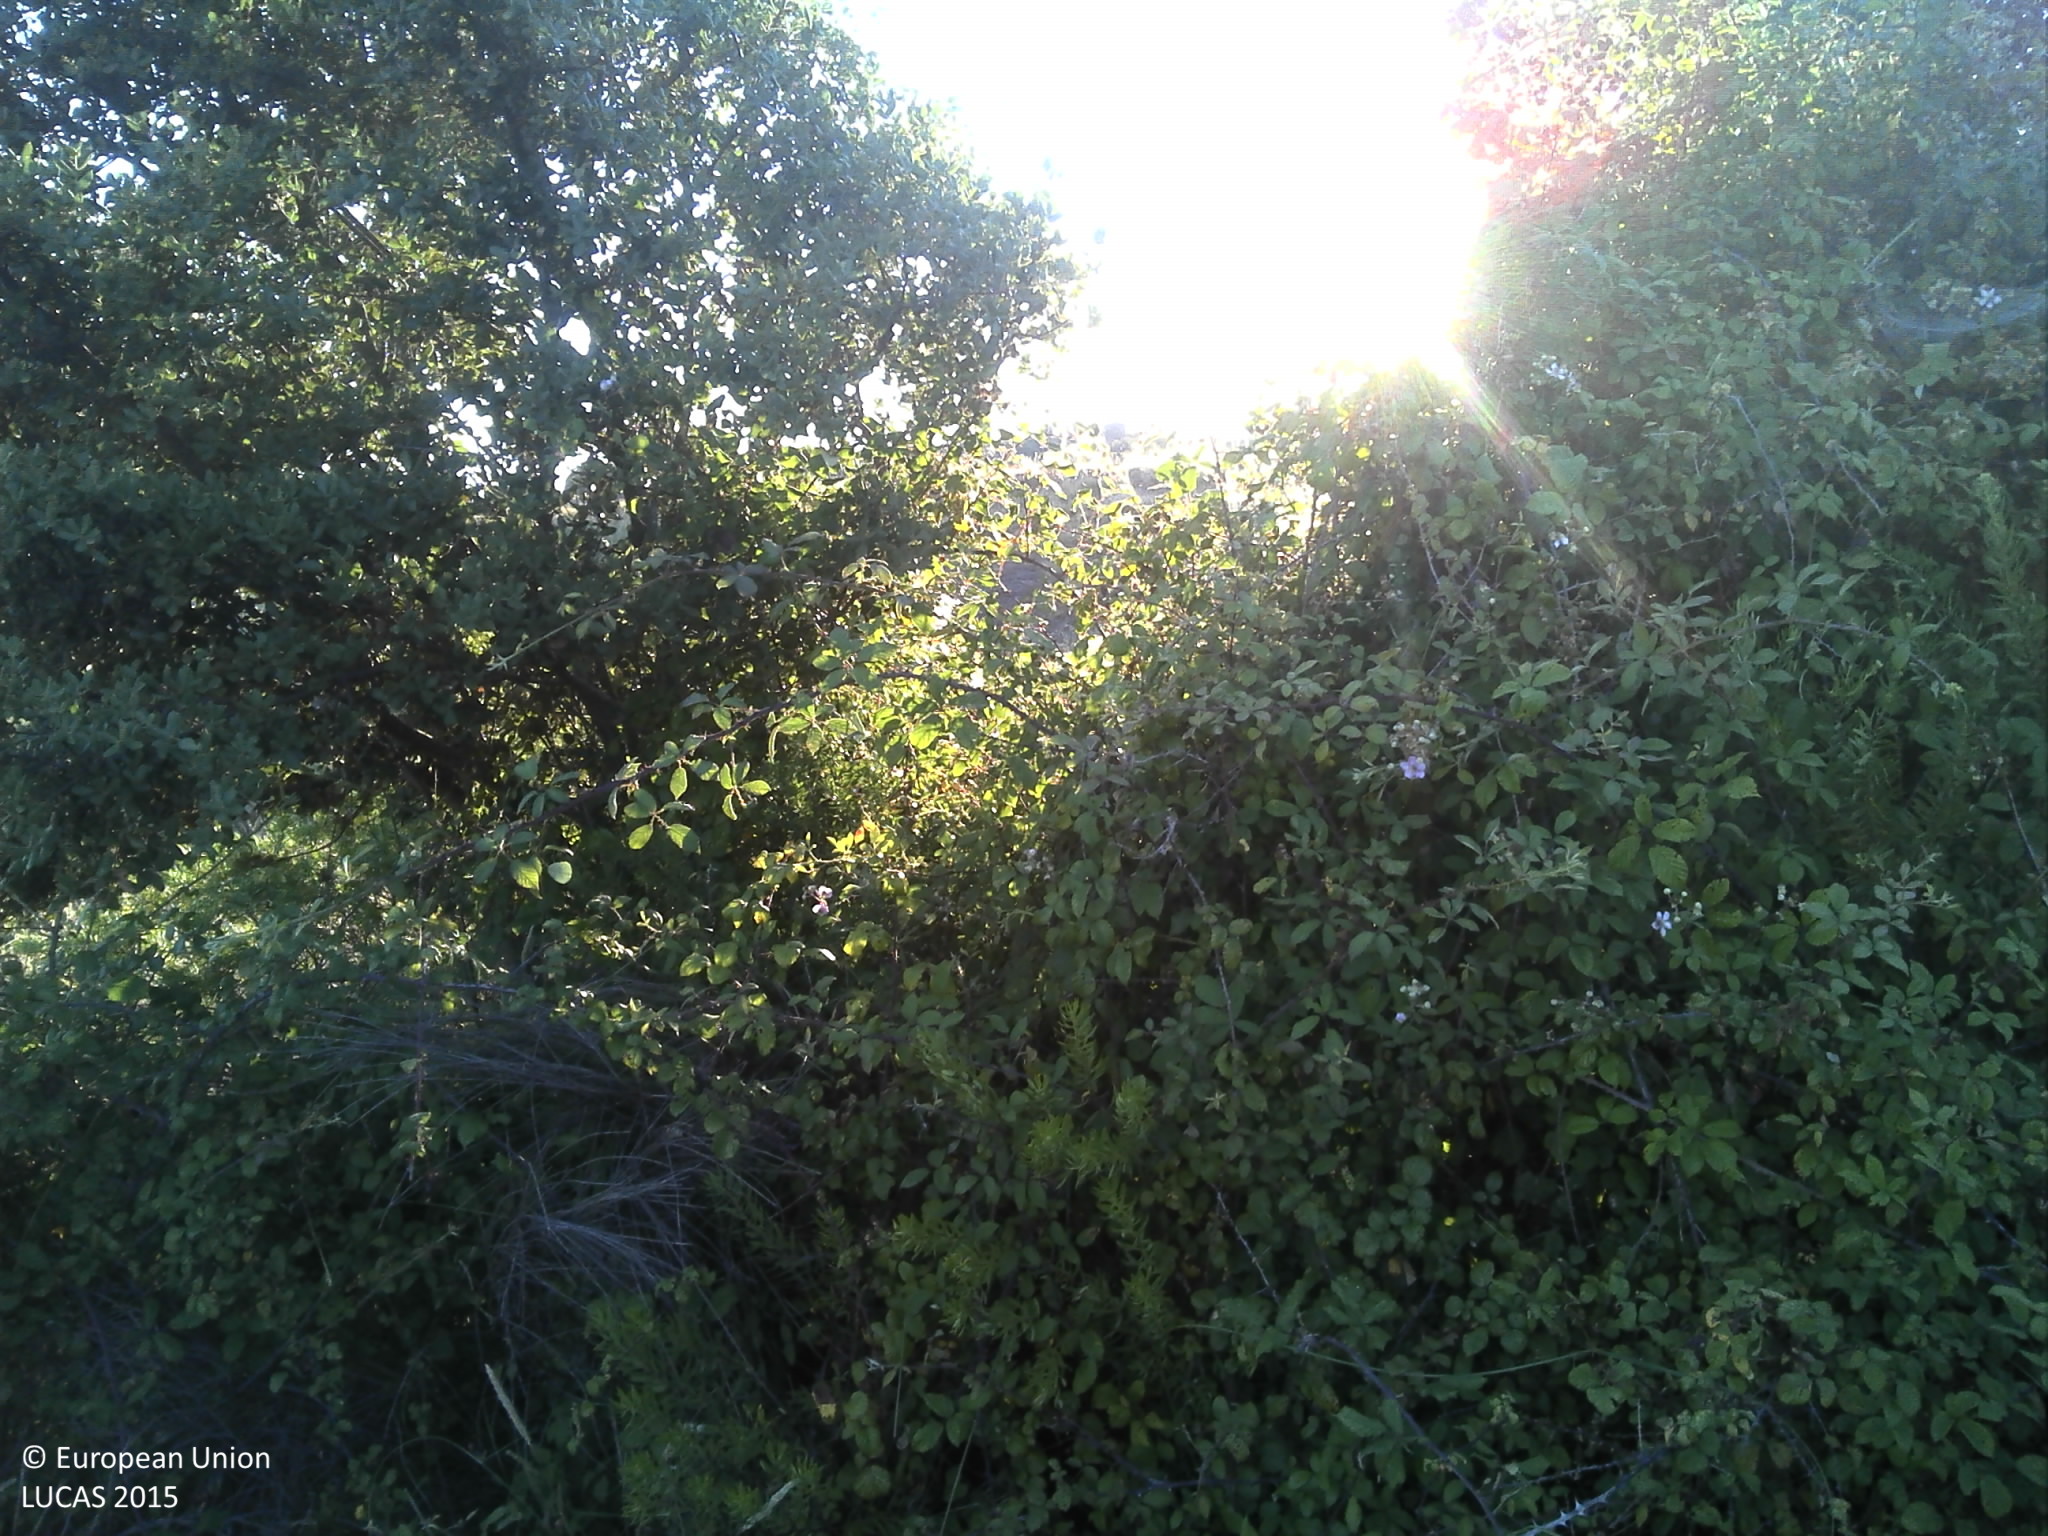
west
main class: Grassland
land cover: Grassland without tree/shrub cover
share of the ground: 50 - 75 %
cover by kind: herbaceous plants 70 %, unconsolidated bare surface 20 %, shrubs 5 %
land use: Agriculture (excluding fallow land and kitchen gardens)
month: June
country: PT
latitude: 39.9819
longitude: -7.3474
